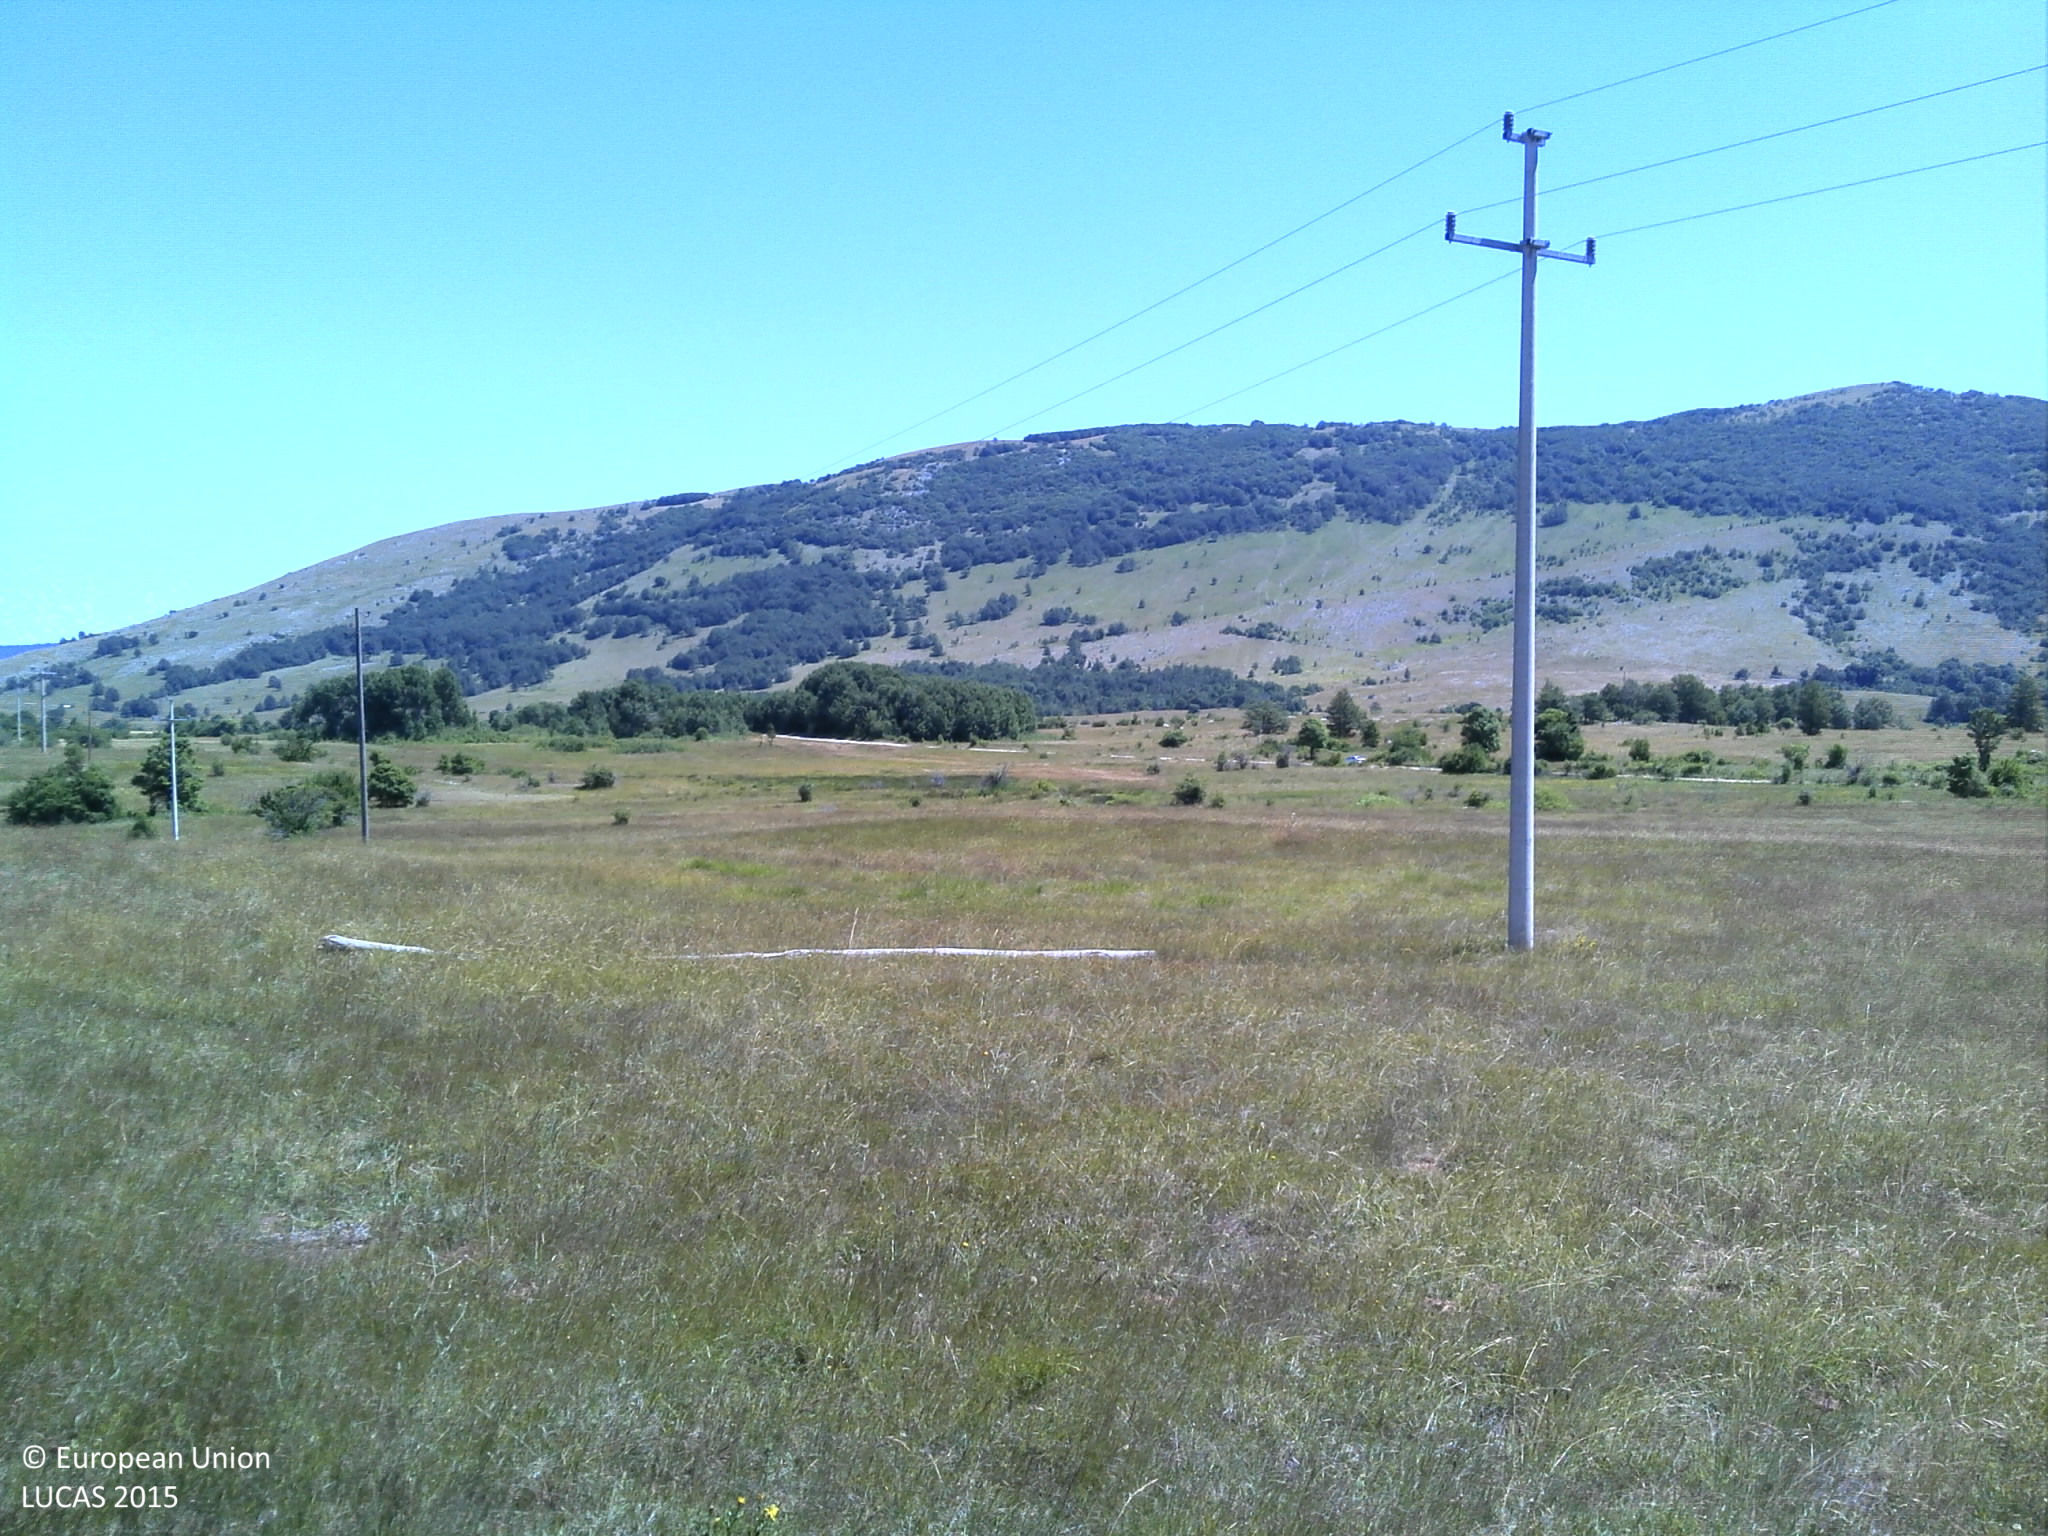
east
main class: Grassland
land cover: Grassland without tree/shrub cover
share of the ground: > 75 %
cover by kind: herbaceous plants 95 %, shrubs 5 %
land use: Agriculture (excluding fallow land and kitchen gardens)
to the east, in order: Grassland without tree/shrub cover; Electric lines; Grassland without tree/shrub cover; Tracks; Grassland without tree/shrub cover; Ditches and canals; Grassland without tree/shrub cover; Single bushes/trees; Paved roads, cycling and walking lanes
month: July
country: HR
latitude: 44.4172
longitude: 15.9089
